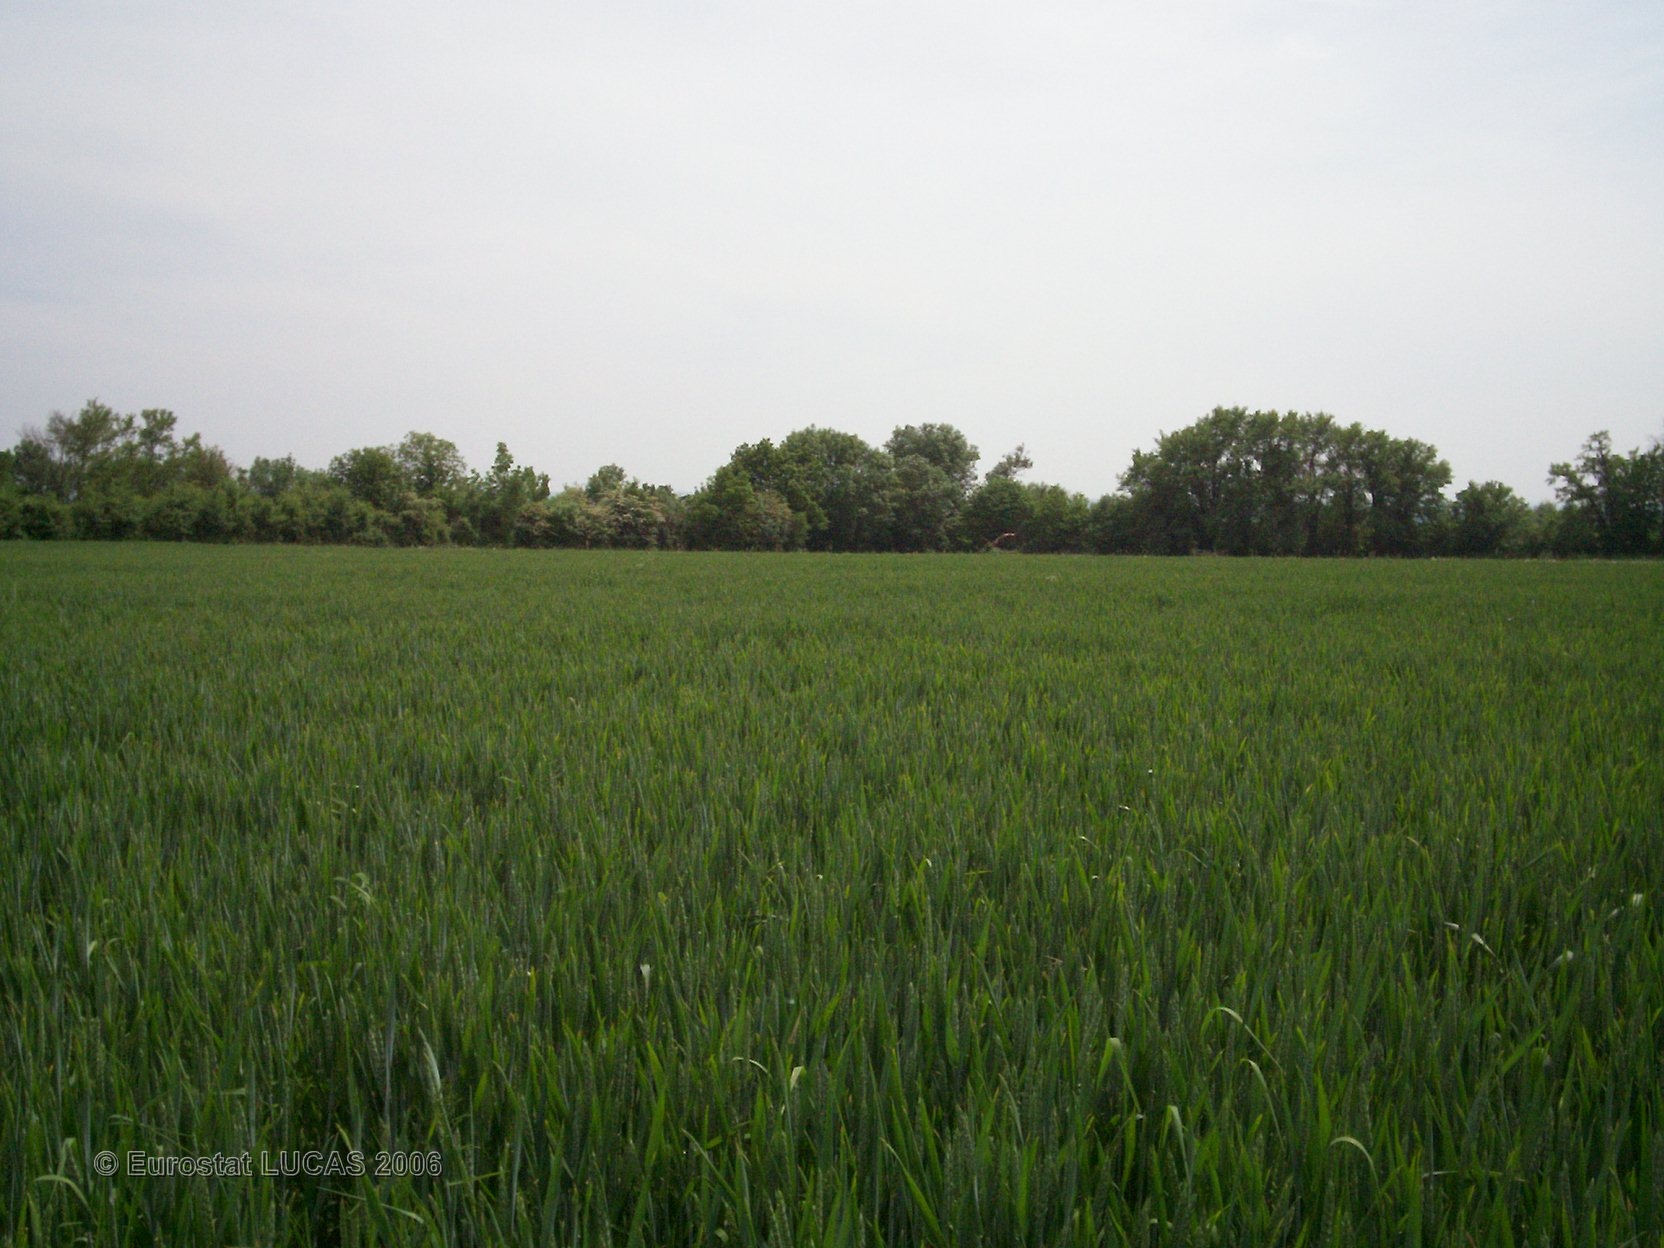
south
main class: Cropland
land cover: Common wheat
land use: Agriculture (excluding fallow land and kitchen gardens)
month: May
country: FR
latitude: 46.4698
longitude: -0.2996
